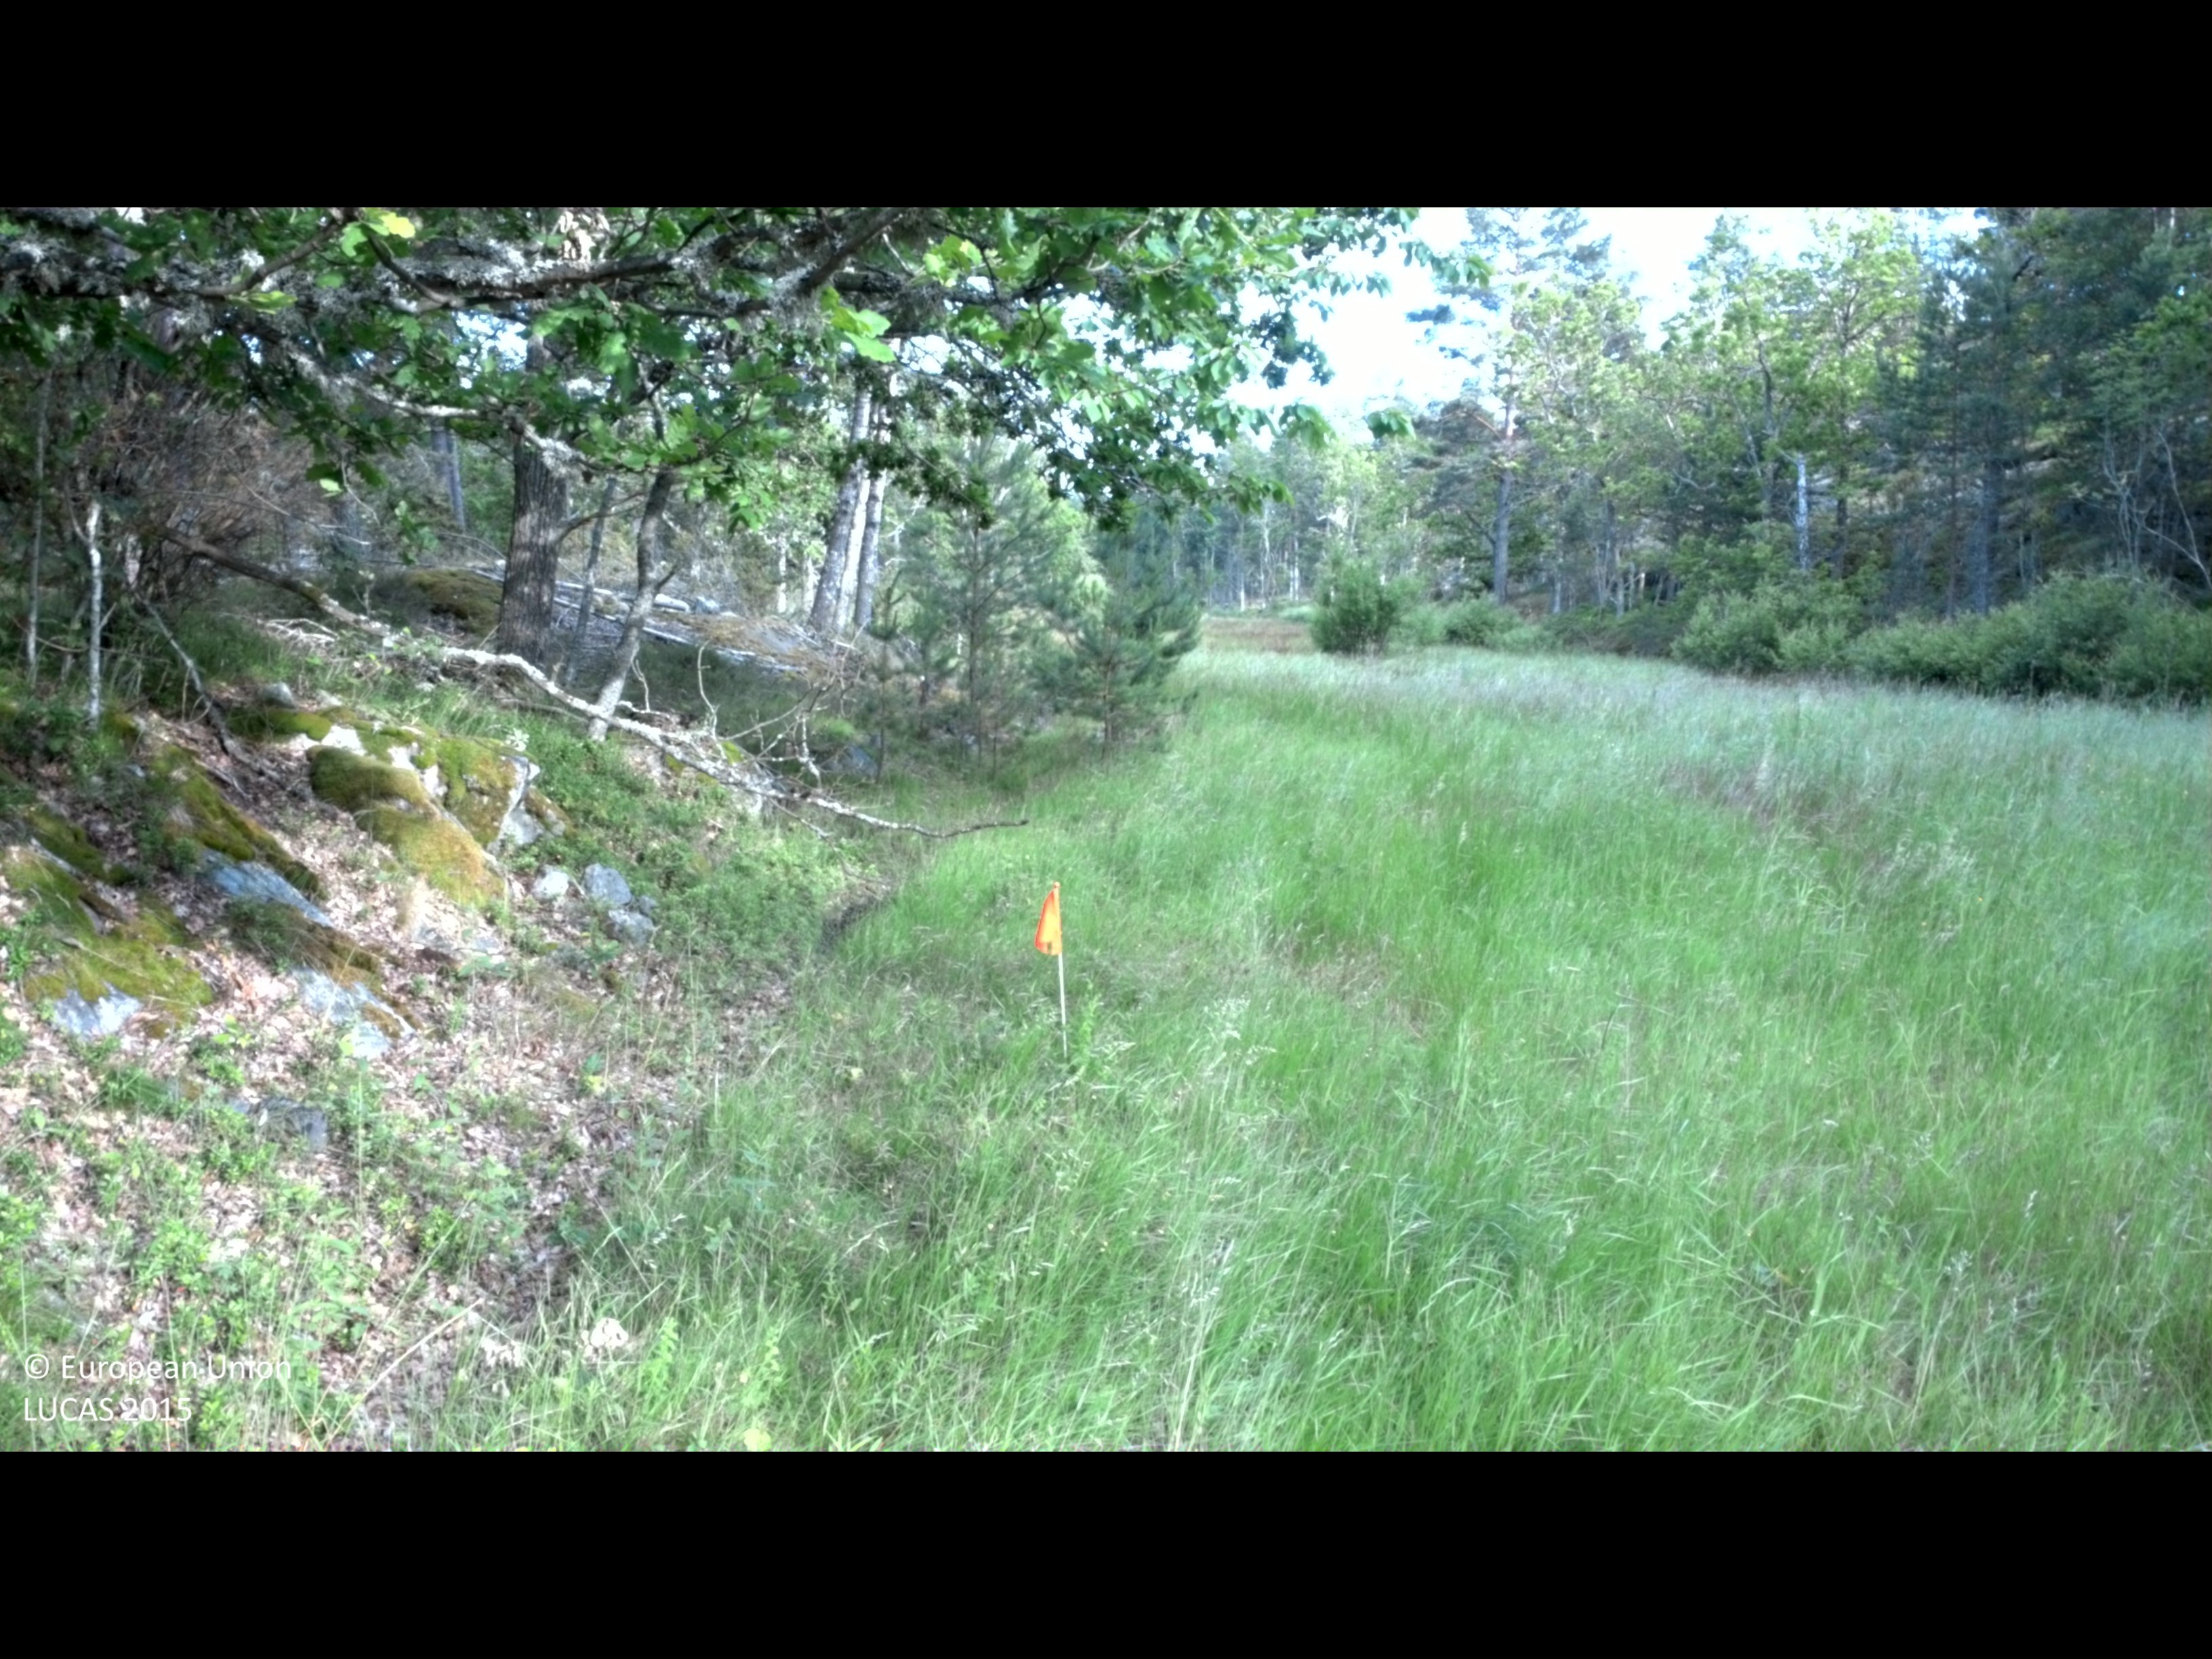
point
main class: Grassland
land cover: Grassland without tree/shrub cover
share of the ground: > 75 %
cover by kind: herbaceous plants 90 %, lichens and mosses 10 %
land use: Agriculture (excluding fallow land and kitchen gardens)
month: June
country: SE
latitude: 57.9975
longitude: 16.7148
